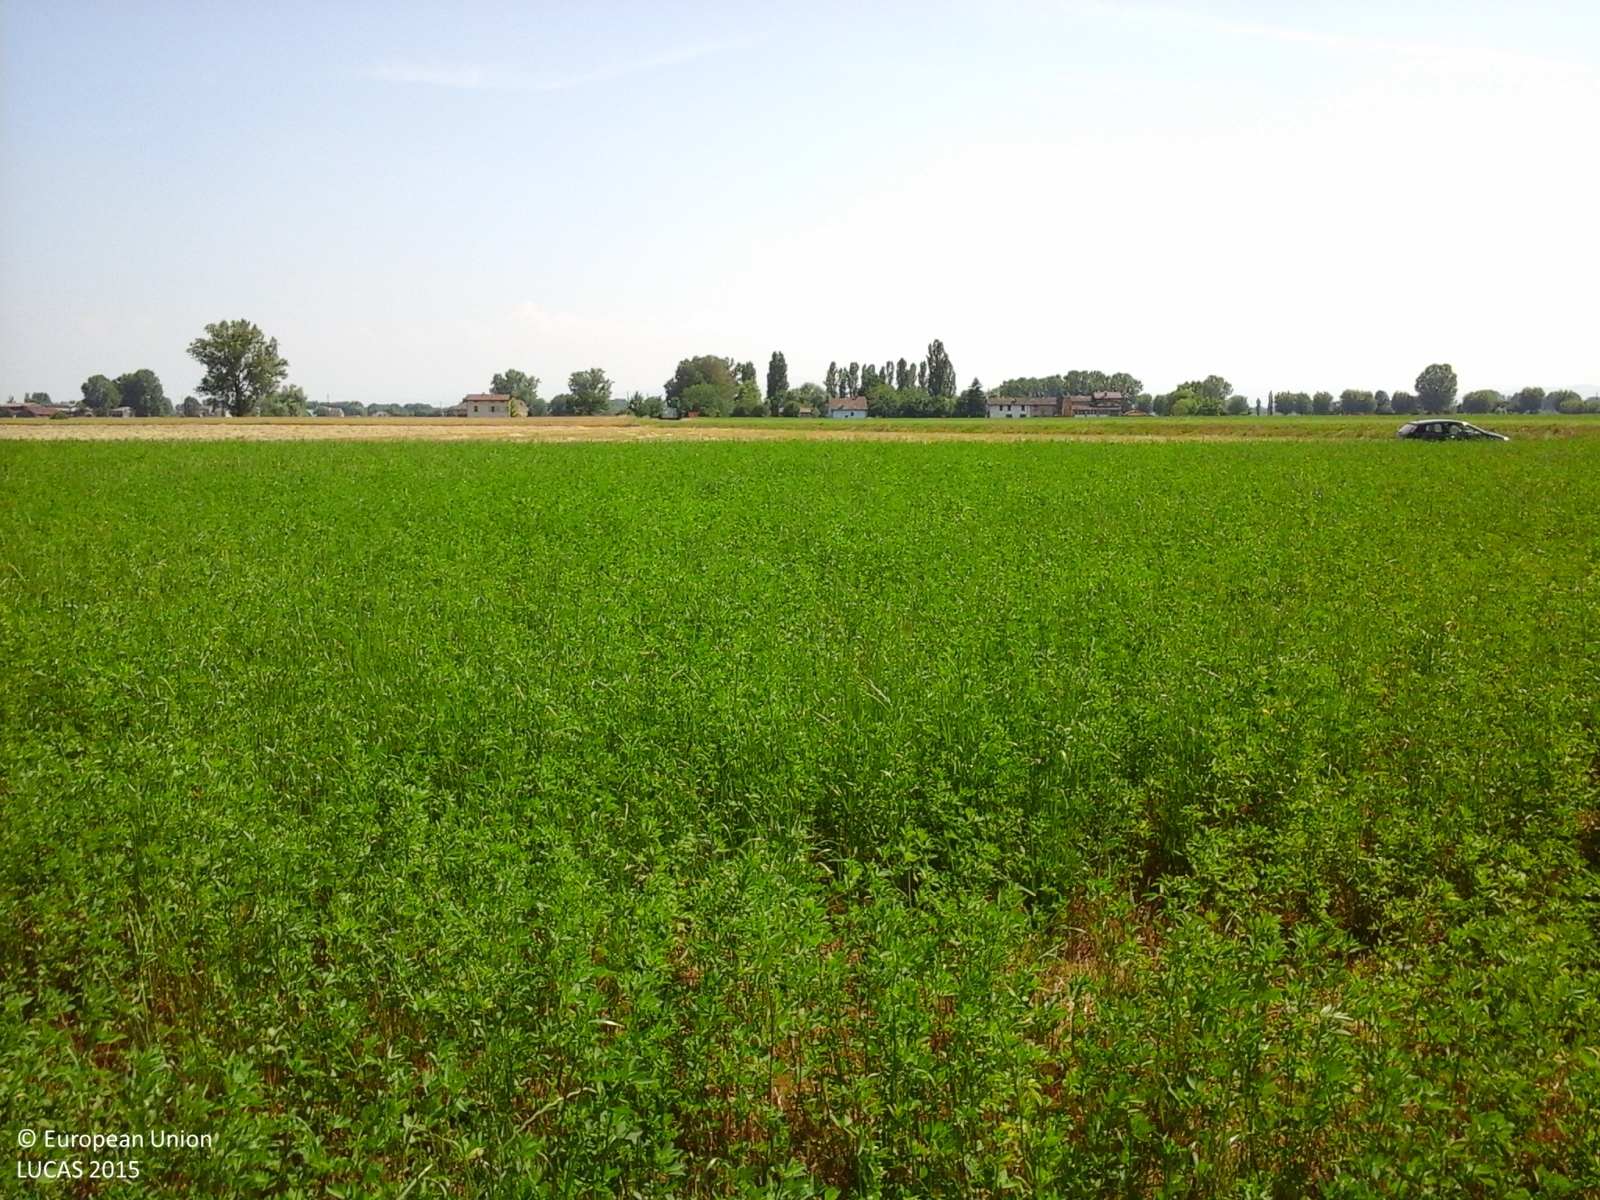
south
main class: Cropland
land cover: Lucerne
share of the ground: > 75 %
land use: Agriculture (excluding fallow land and kitchen gardens)
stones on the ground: < 10 %
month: May
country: IT
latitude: 44.9093
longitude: 10.2149
